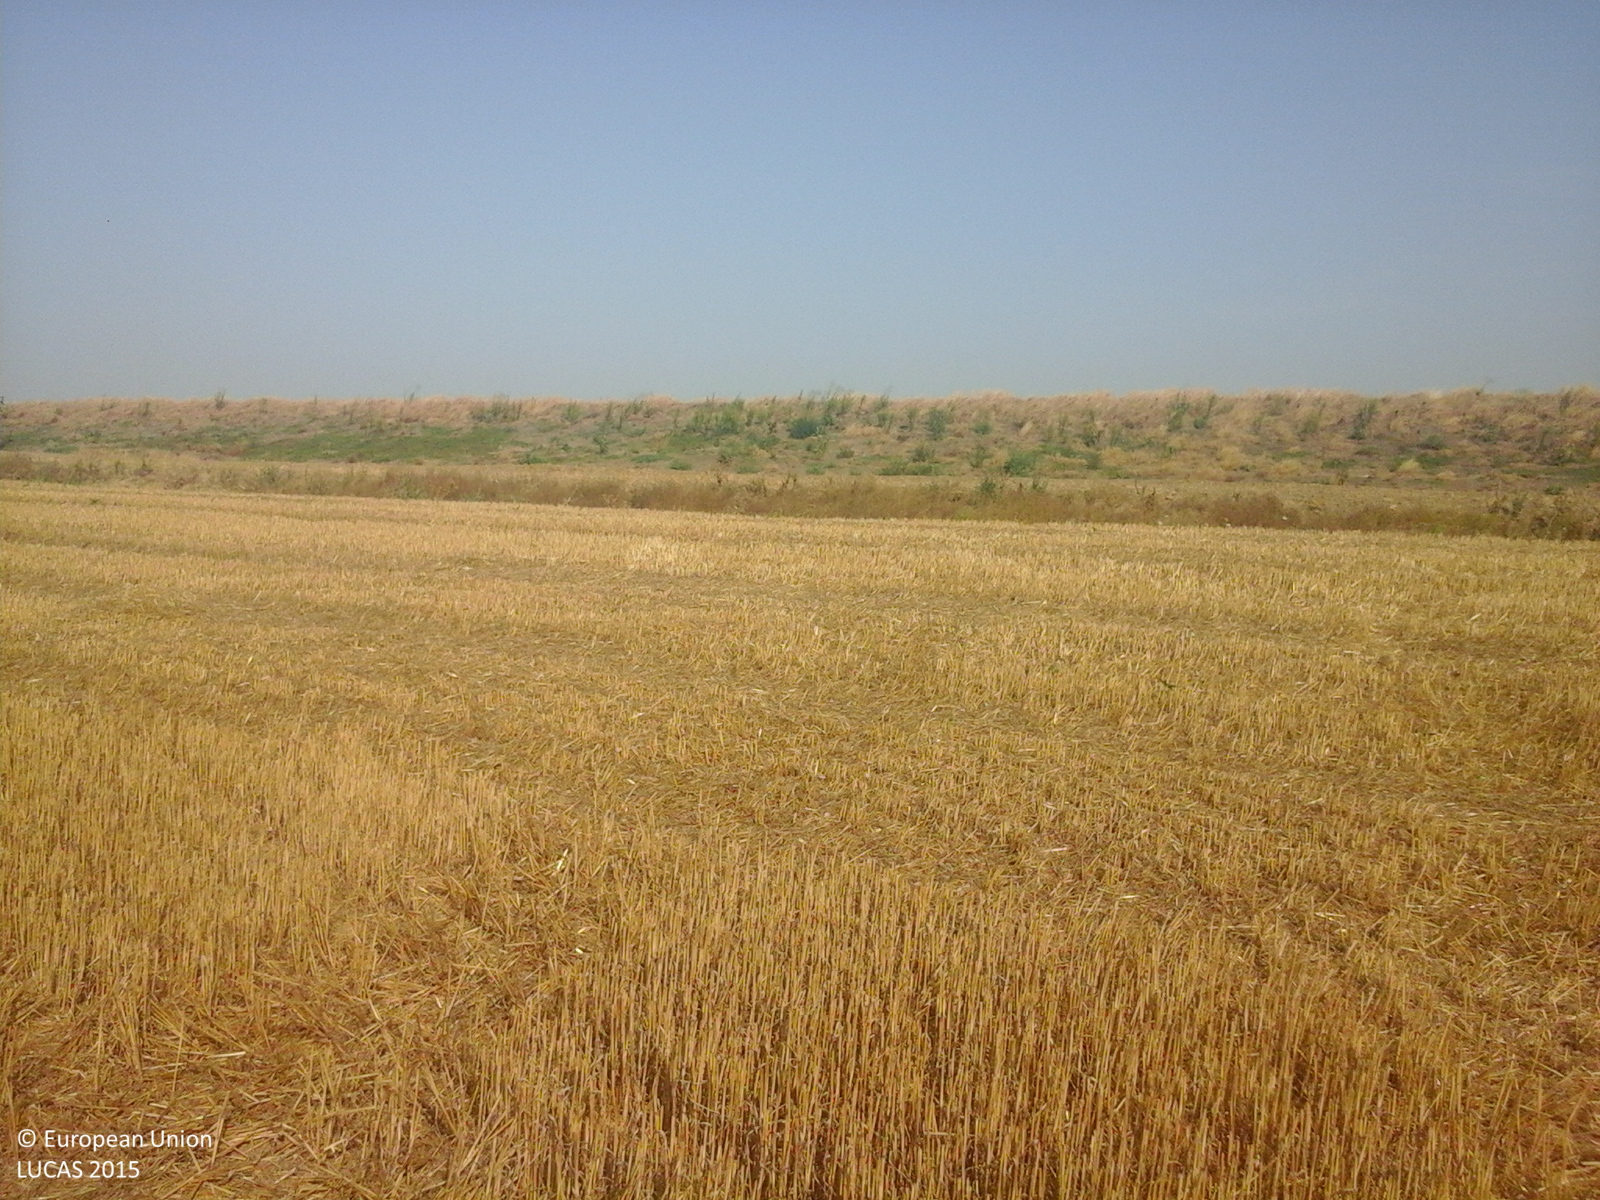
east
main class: Artificial land
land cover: Other artificial areas
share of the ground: > 75 %
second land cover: Durum wheat
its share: 10 - 25 %
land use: Electricity, gas and thermal power distribution
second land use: Agriculture (excluding fallow land and kitchen gardens)
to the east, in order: Artificial constructions in urban areas; Durum wheat; Grass margins; Ditches and canals; Grass margins; Common wheat; Grassland without tree/shrub cover; Tracks; Grassland without tree/shrub cover; Sunflower
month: August
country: RO
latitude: 44.8860
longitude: 28.0798
